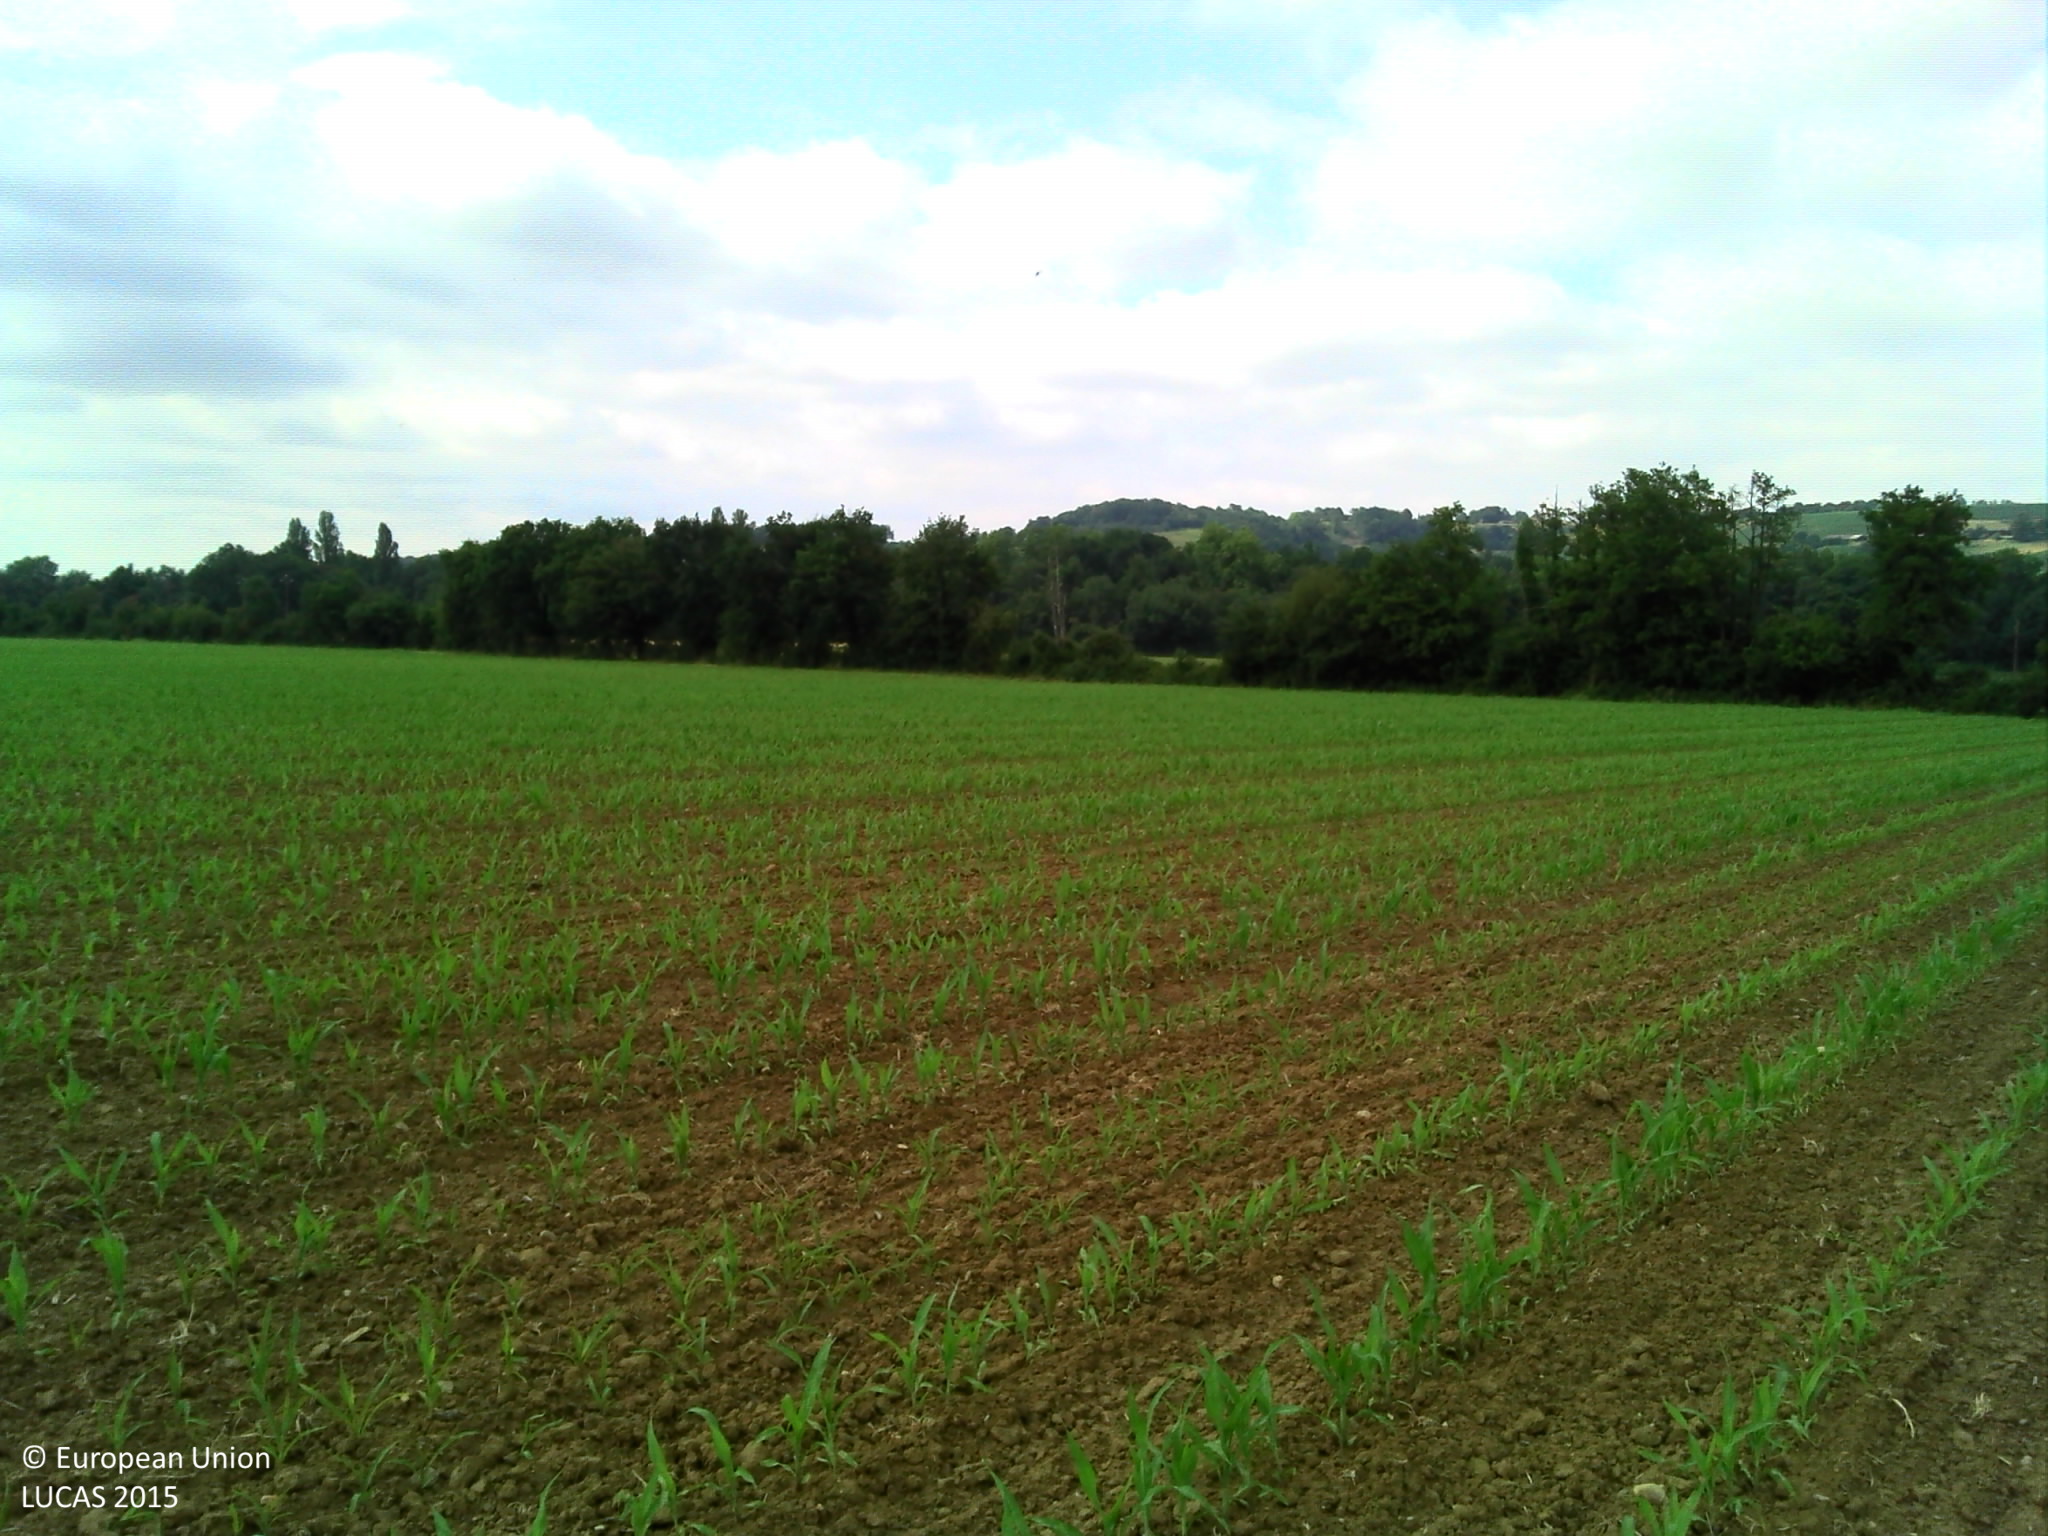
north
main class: Cropland
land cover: Maize
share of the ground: 10 - 25 %
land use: Agriculture (excluding fallow land and kitchen gardens)
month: June
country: FR
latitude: 43.6100
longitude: -0.2046
